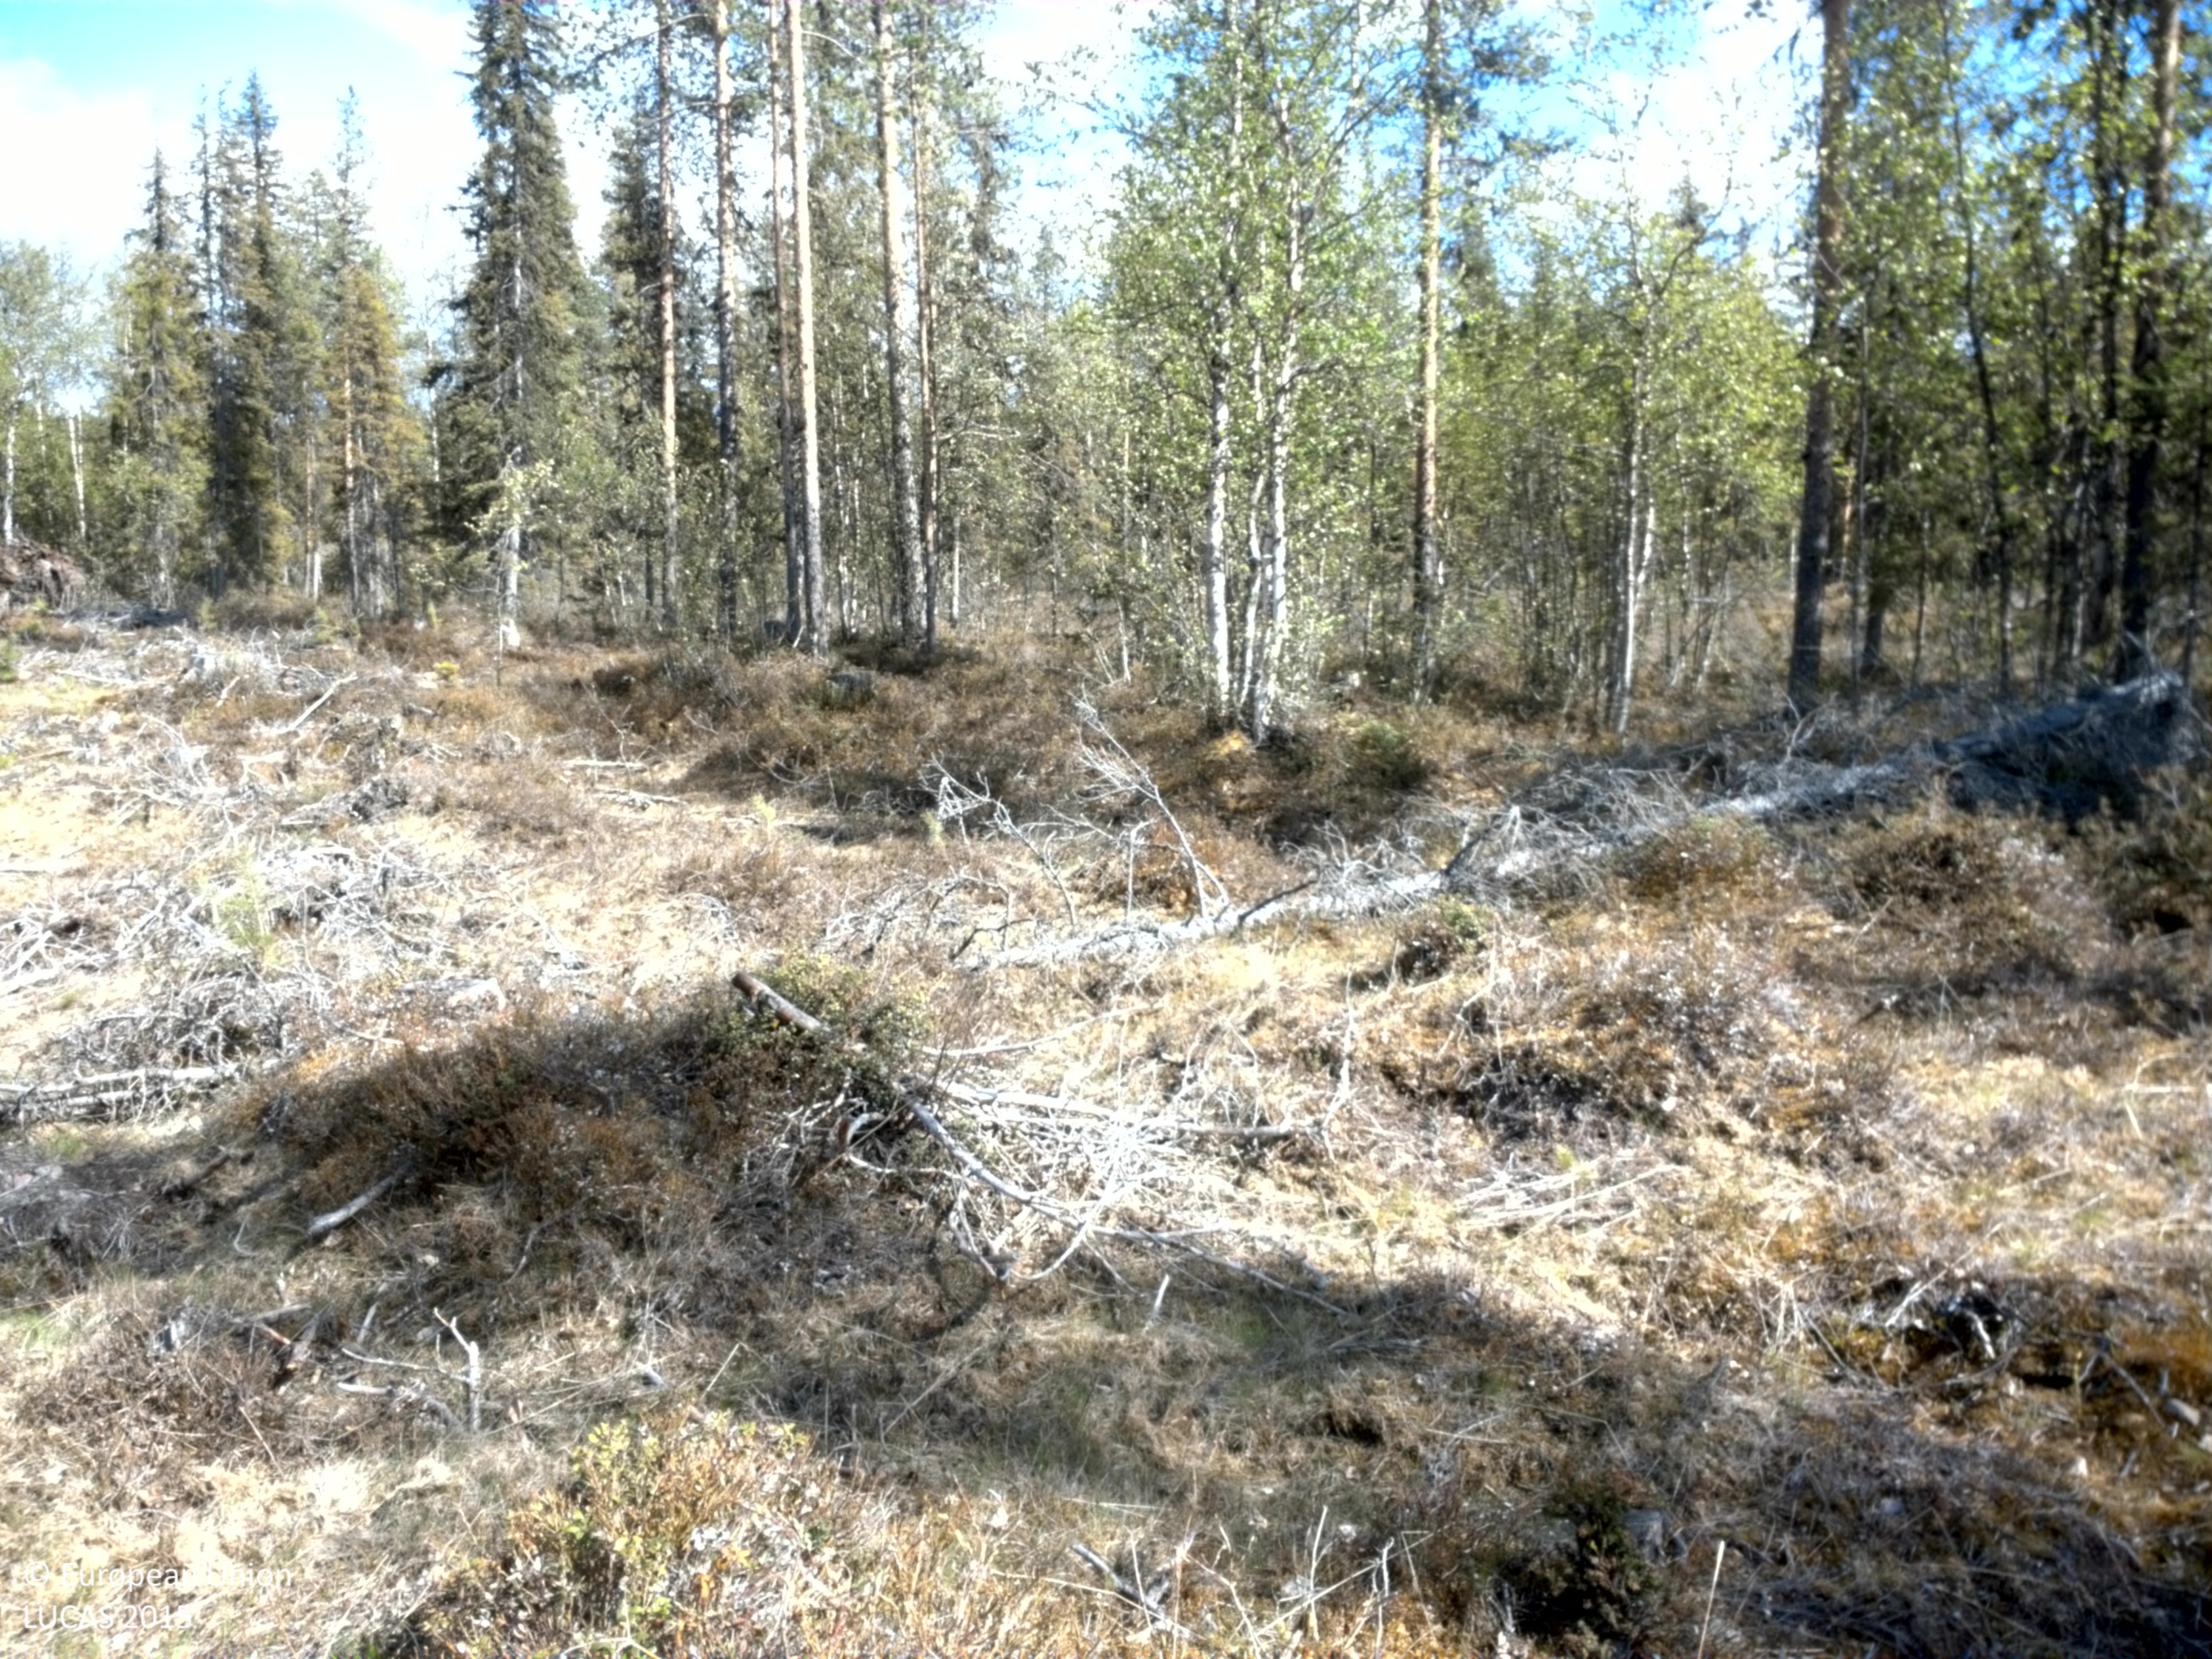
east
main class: Shrubland
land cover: Shrubland with sparse tree cover
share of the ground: 10 - 25 %
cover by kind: herbaceous plants 55 %, unconsolidated bare surface 25 %, shrubs 15 %, coniferous forest trees 5 %
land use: Forestry
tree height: < 5 m
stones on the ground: < 10 %
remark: Clear cut
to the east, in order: Shrubland with sparse tree cover; Pine dominated mixed woodland; Spruce dominated coniferous woodland; Rivers and streams; Spruce dominated coniferous woodland; Other coniferous woodland; Pine dominated coniferous woodland; Spruce dominated coniferous woodland; Pine dominated coniferous woodland; Shrubland with sparse tree cover; Pine dominated coniferous woodland; Other bare soil; Shrubland without tree cover
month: June
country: SE
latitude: 66.9747
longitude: 21.3421
